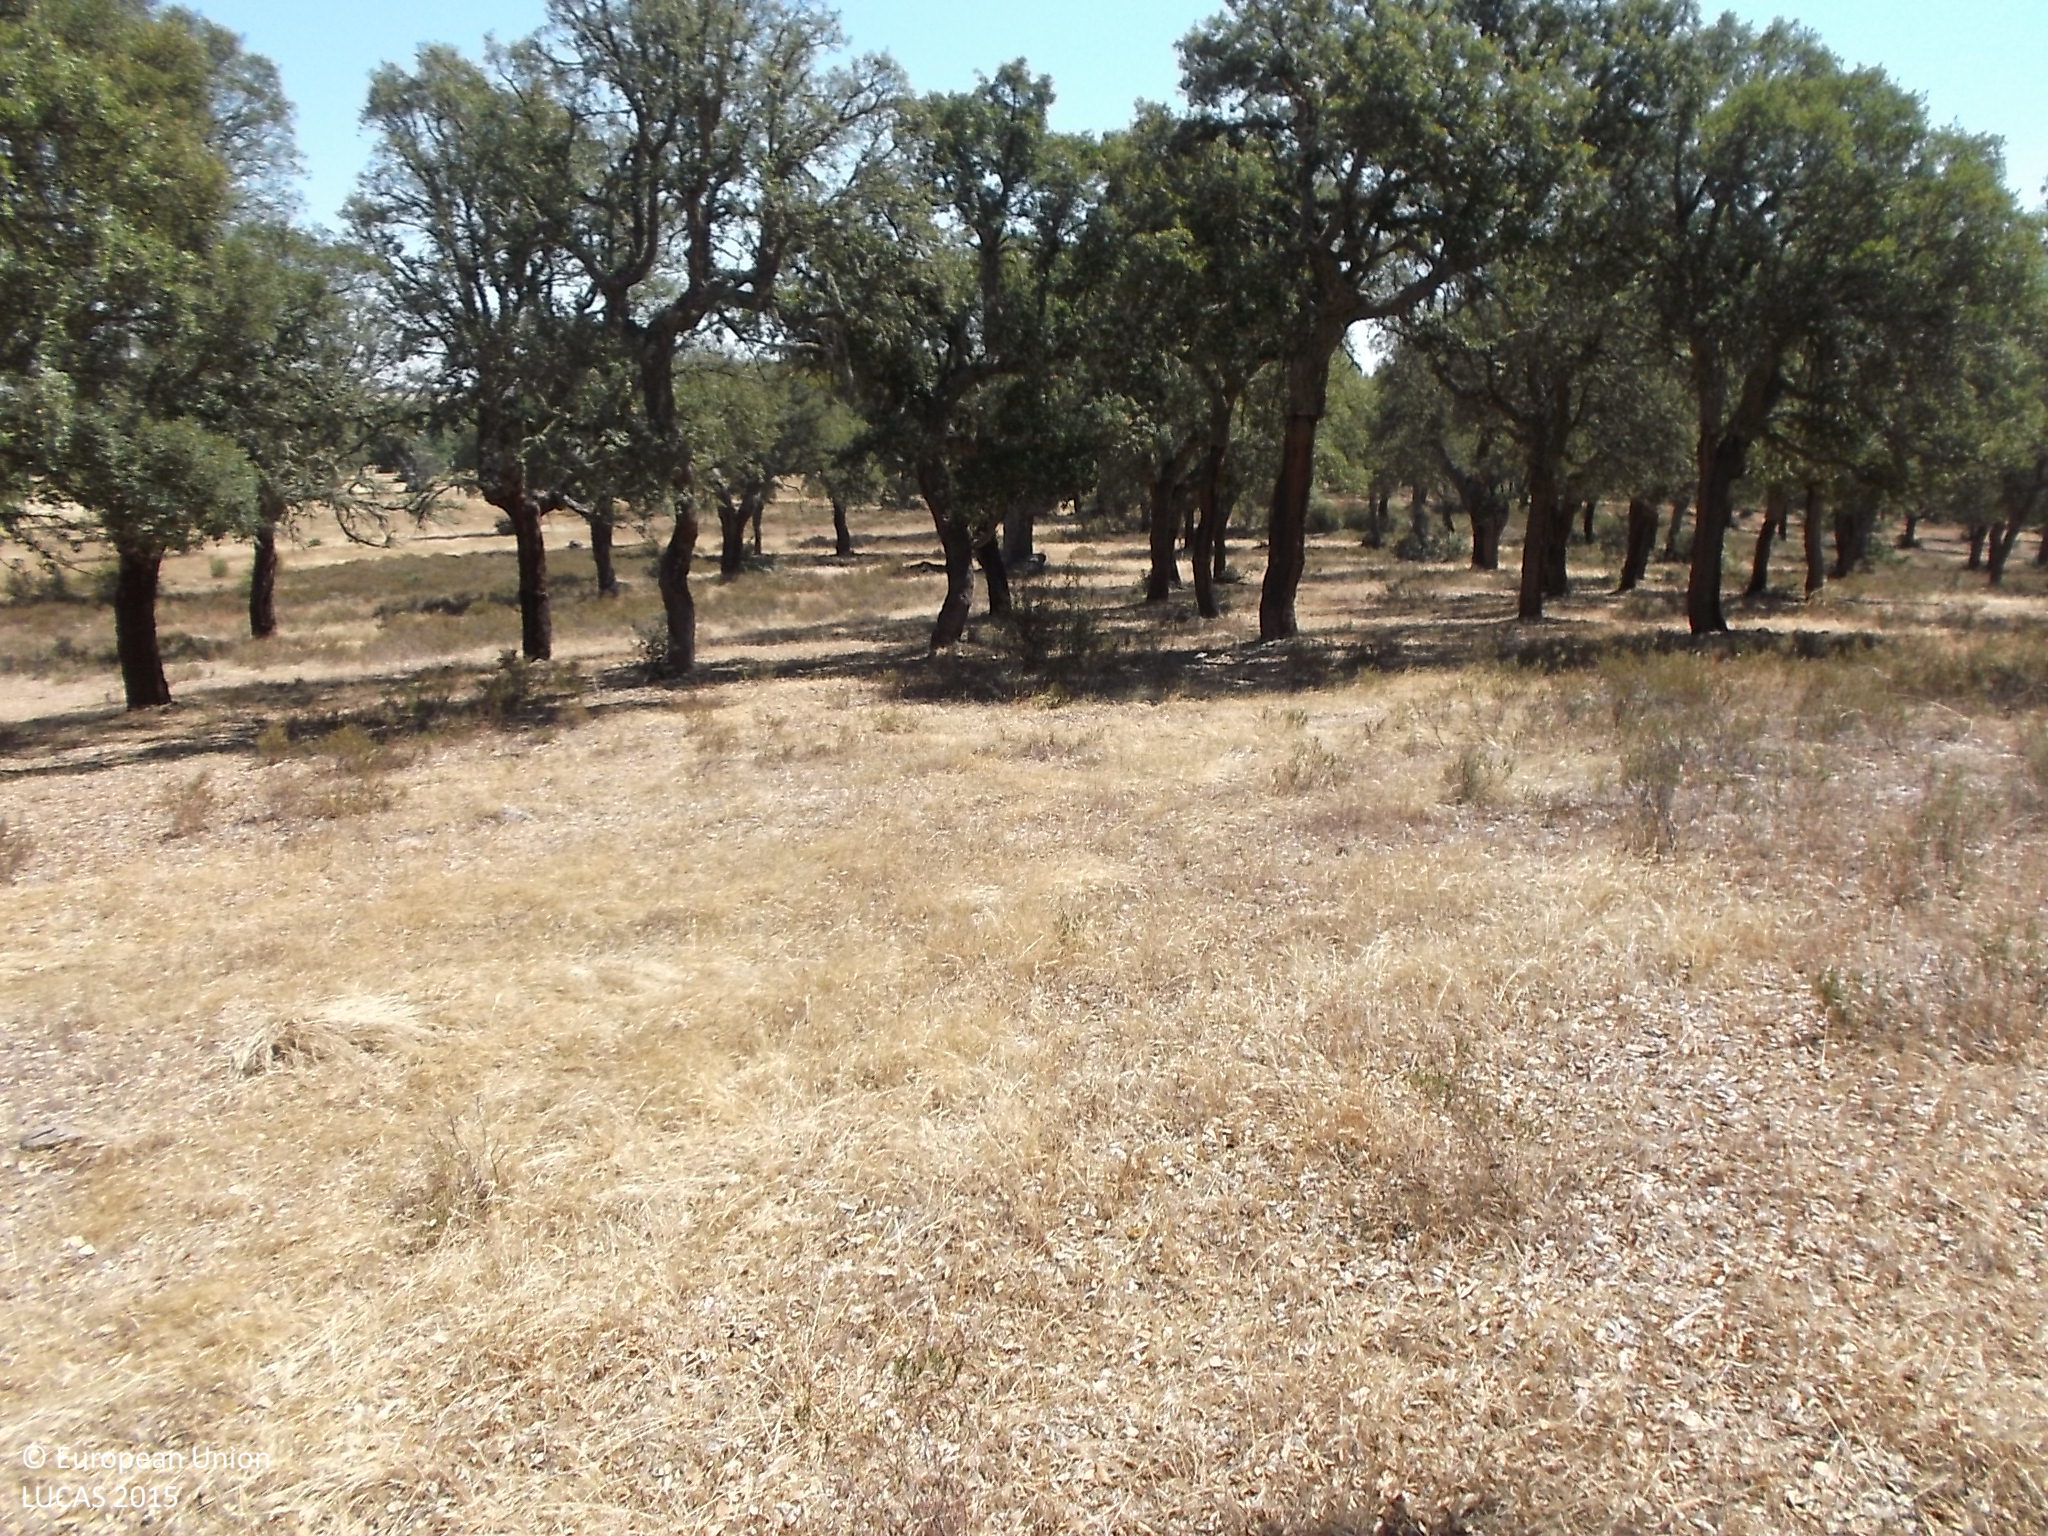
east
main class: Woodland
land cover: Broadleaved woodland
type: broadleaved evergreen forest
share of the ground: 25 - 50 %
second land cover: Shrubland without tree cover
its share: 25 - 50 %
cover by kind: broadleaved forest trees 50 %, shrubs 30 %, herbaceous plants 20 %
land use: Forestry
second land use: Agriculture (excluding fallow land and kitchen gardens)
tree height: < 5 m
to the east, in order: Broadleaved woodland; Shrubland without tree cover
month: July
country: ES
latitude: 41.3242
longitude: -5.8443
